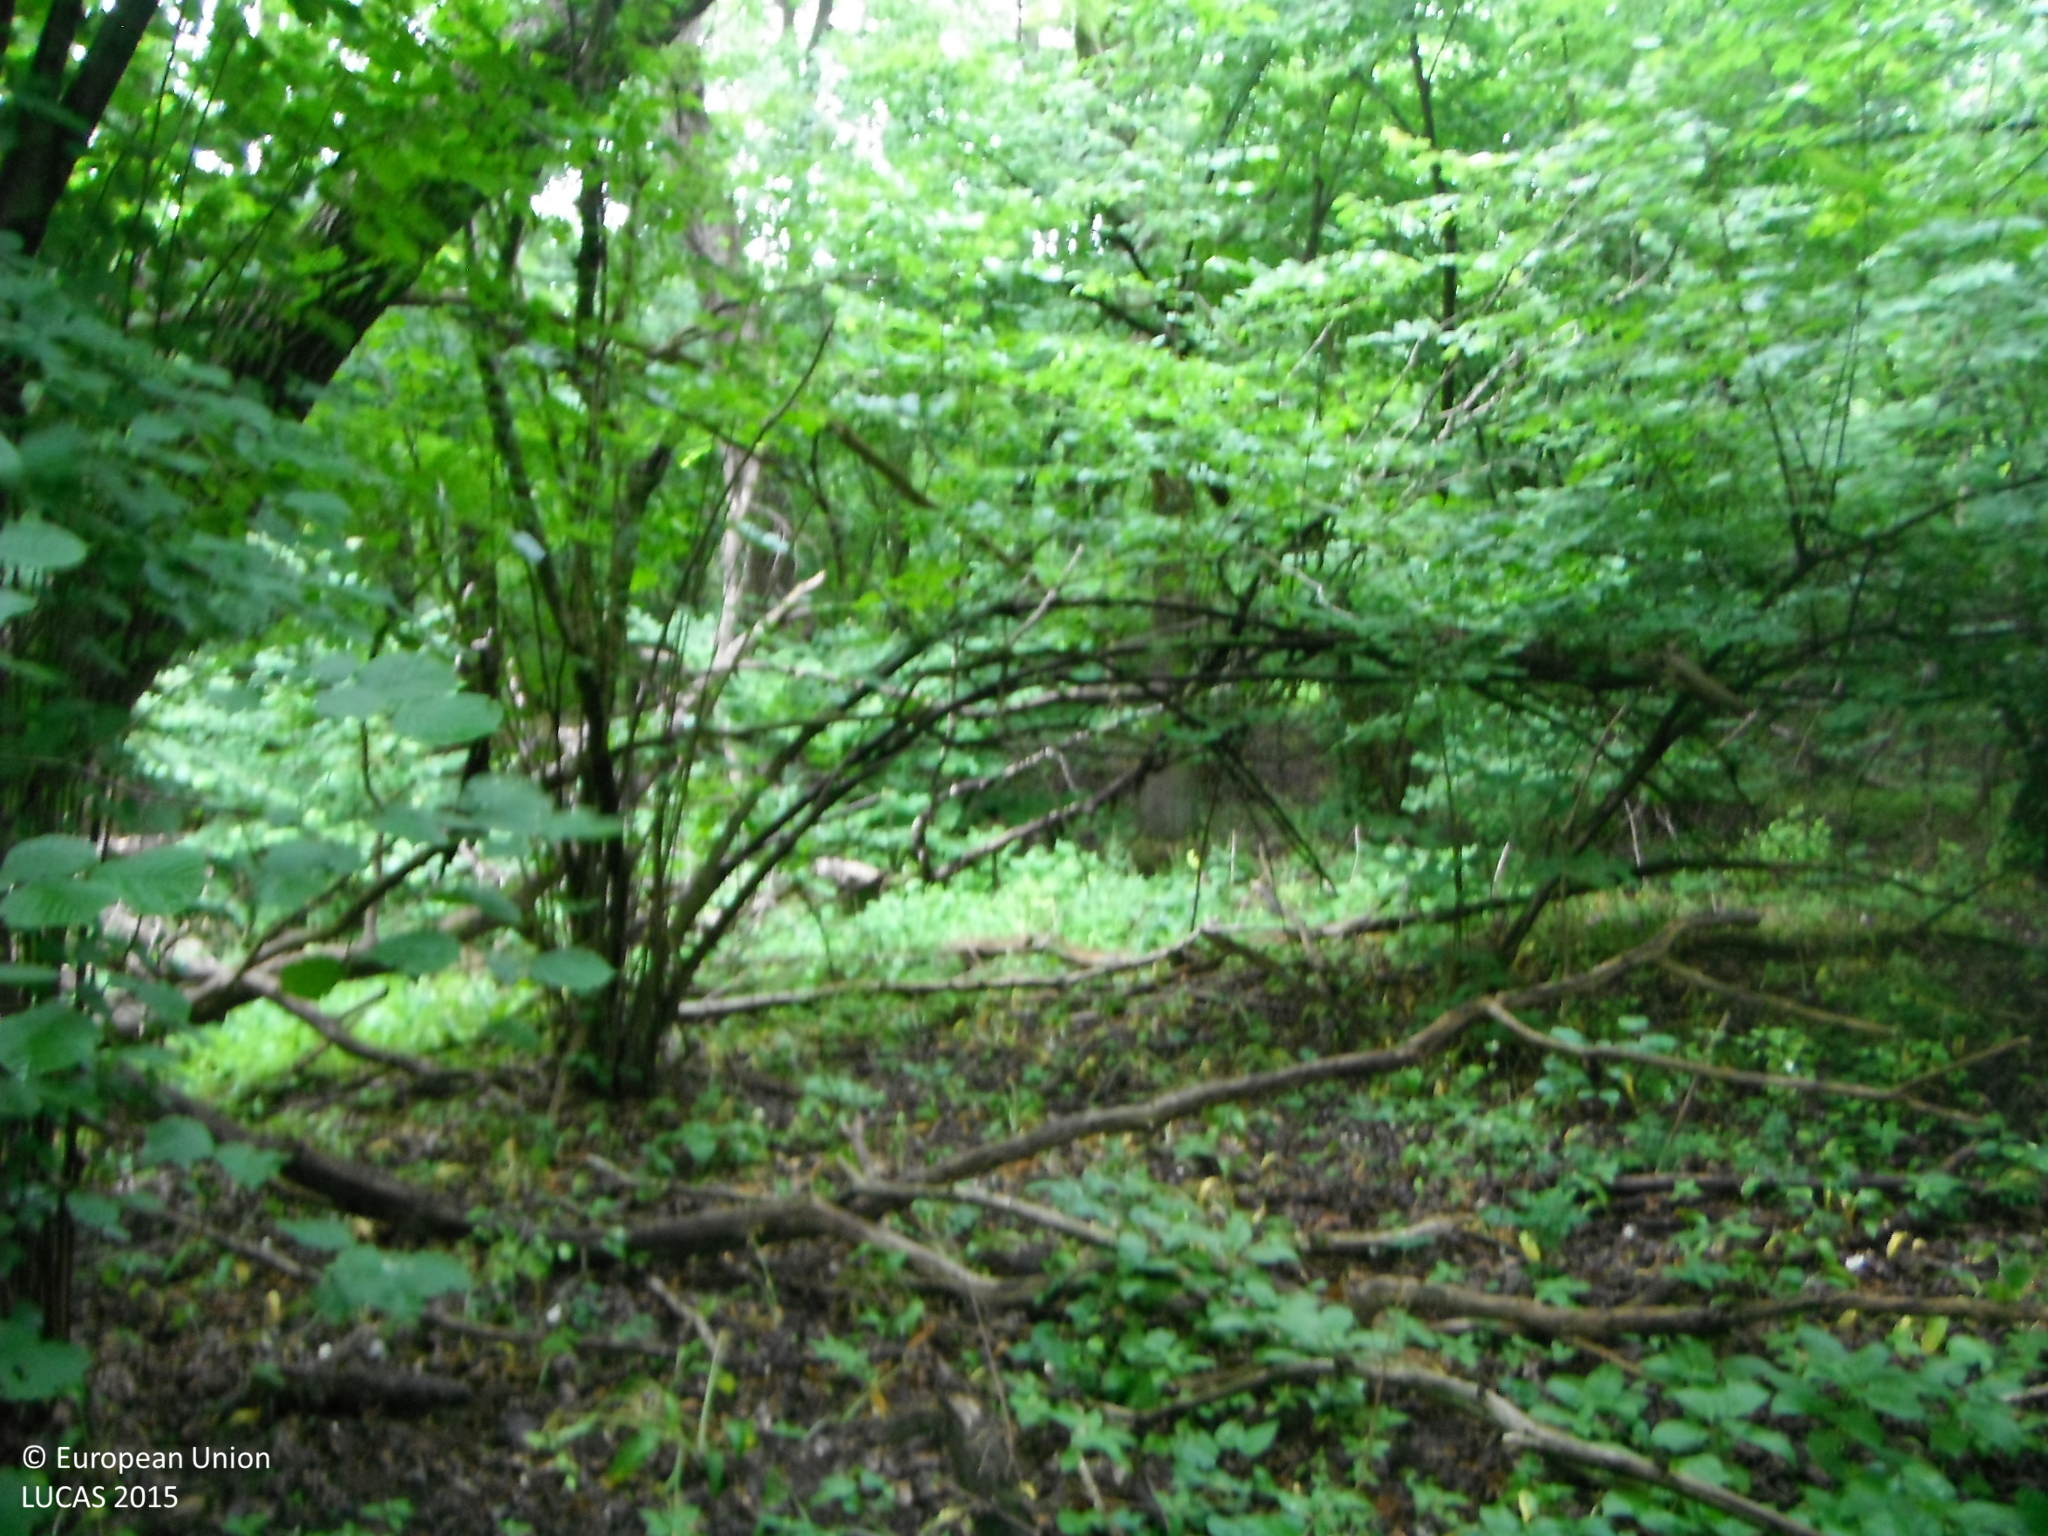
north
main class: Woodland
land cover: Broadleaved woodland
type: floodplain forest
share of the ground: > 75 %
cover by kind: broadleaved forest trees 90 %, herbaceous plants 10 %
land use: Forestry
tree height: > 5 m
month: June
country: SK
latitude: 48.0808
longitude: 17.1627
